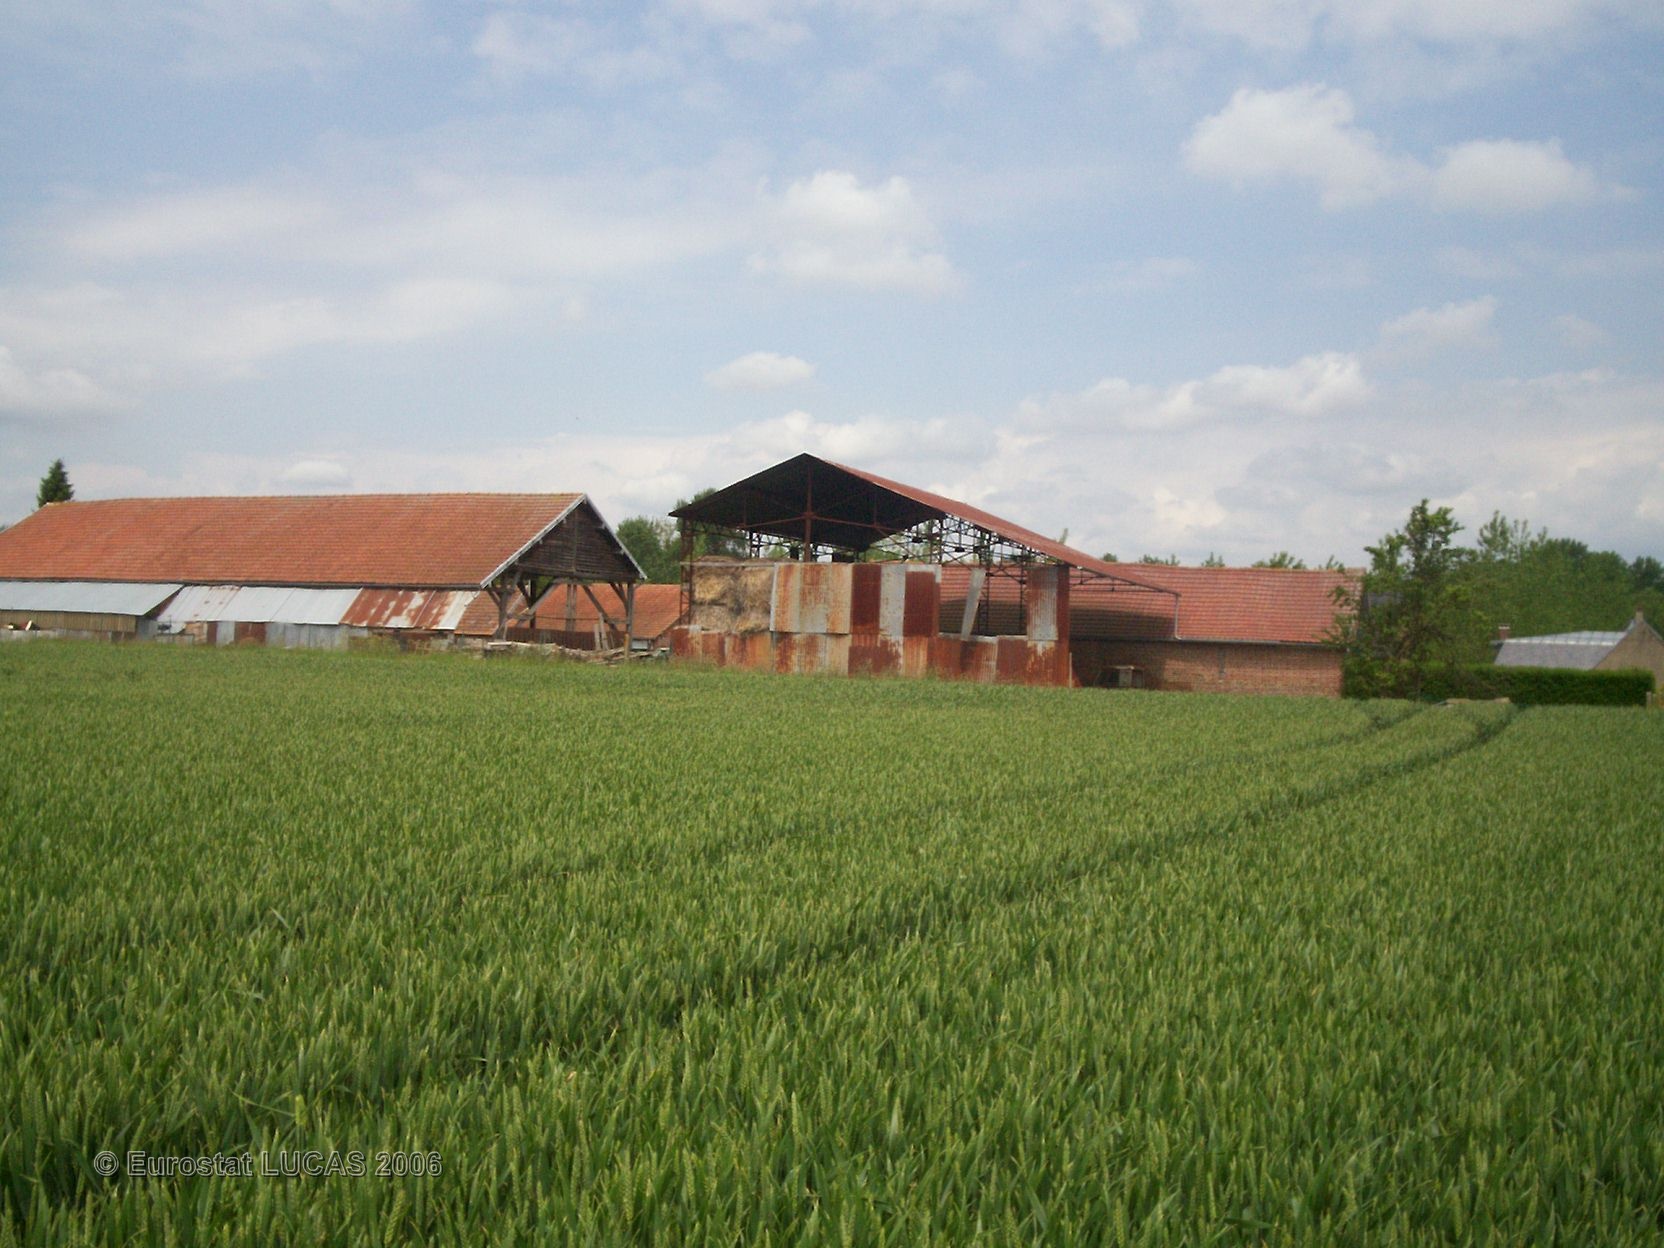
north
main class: Cropland
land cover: Common wheat
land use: Agriculture (excluding fallow land and kitchen gardens)
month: June
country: FR
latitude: 49.6926
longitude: 2.6275
